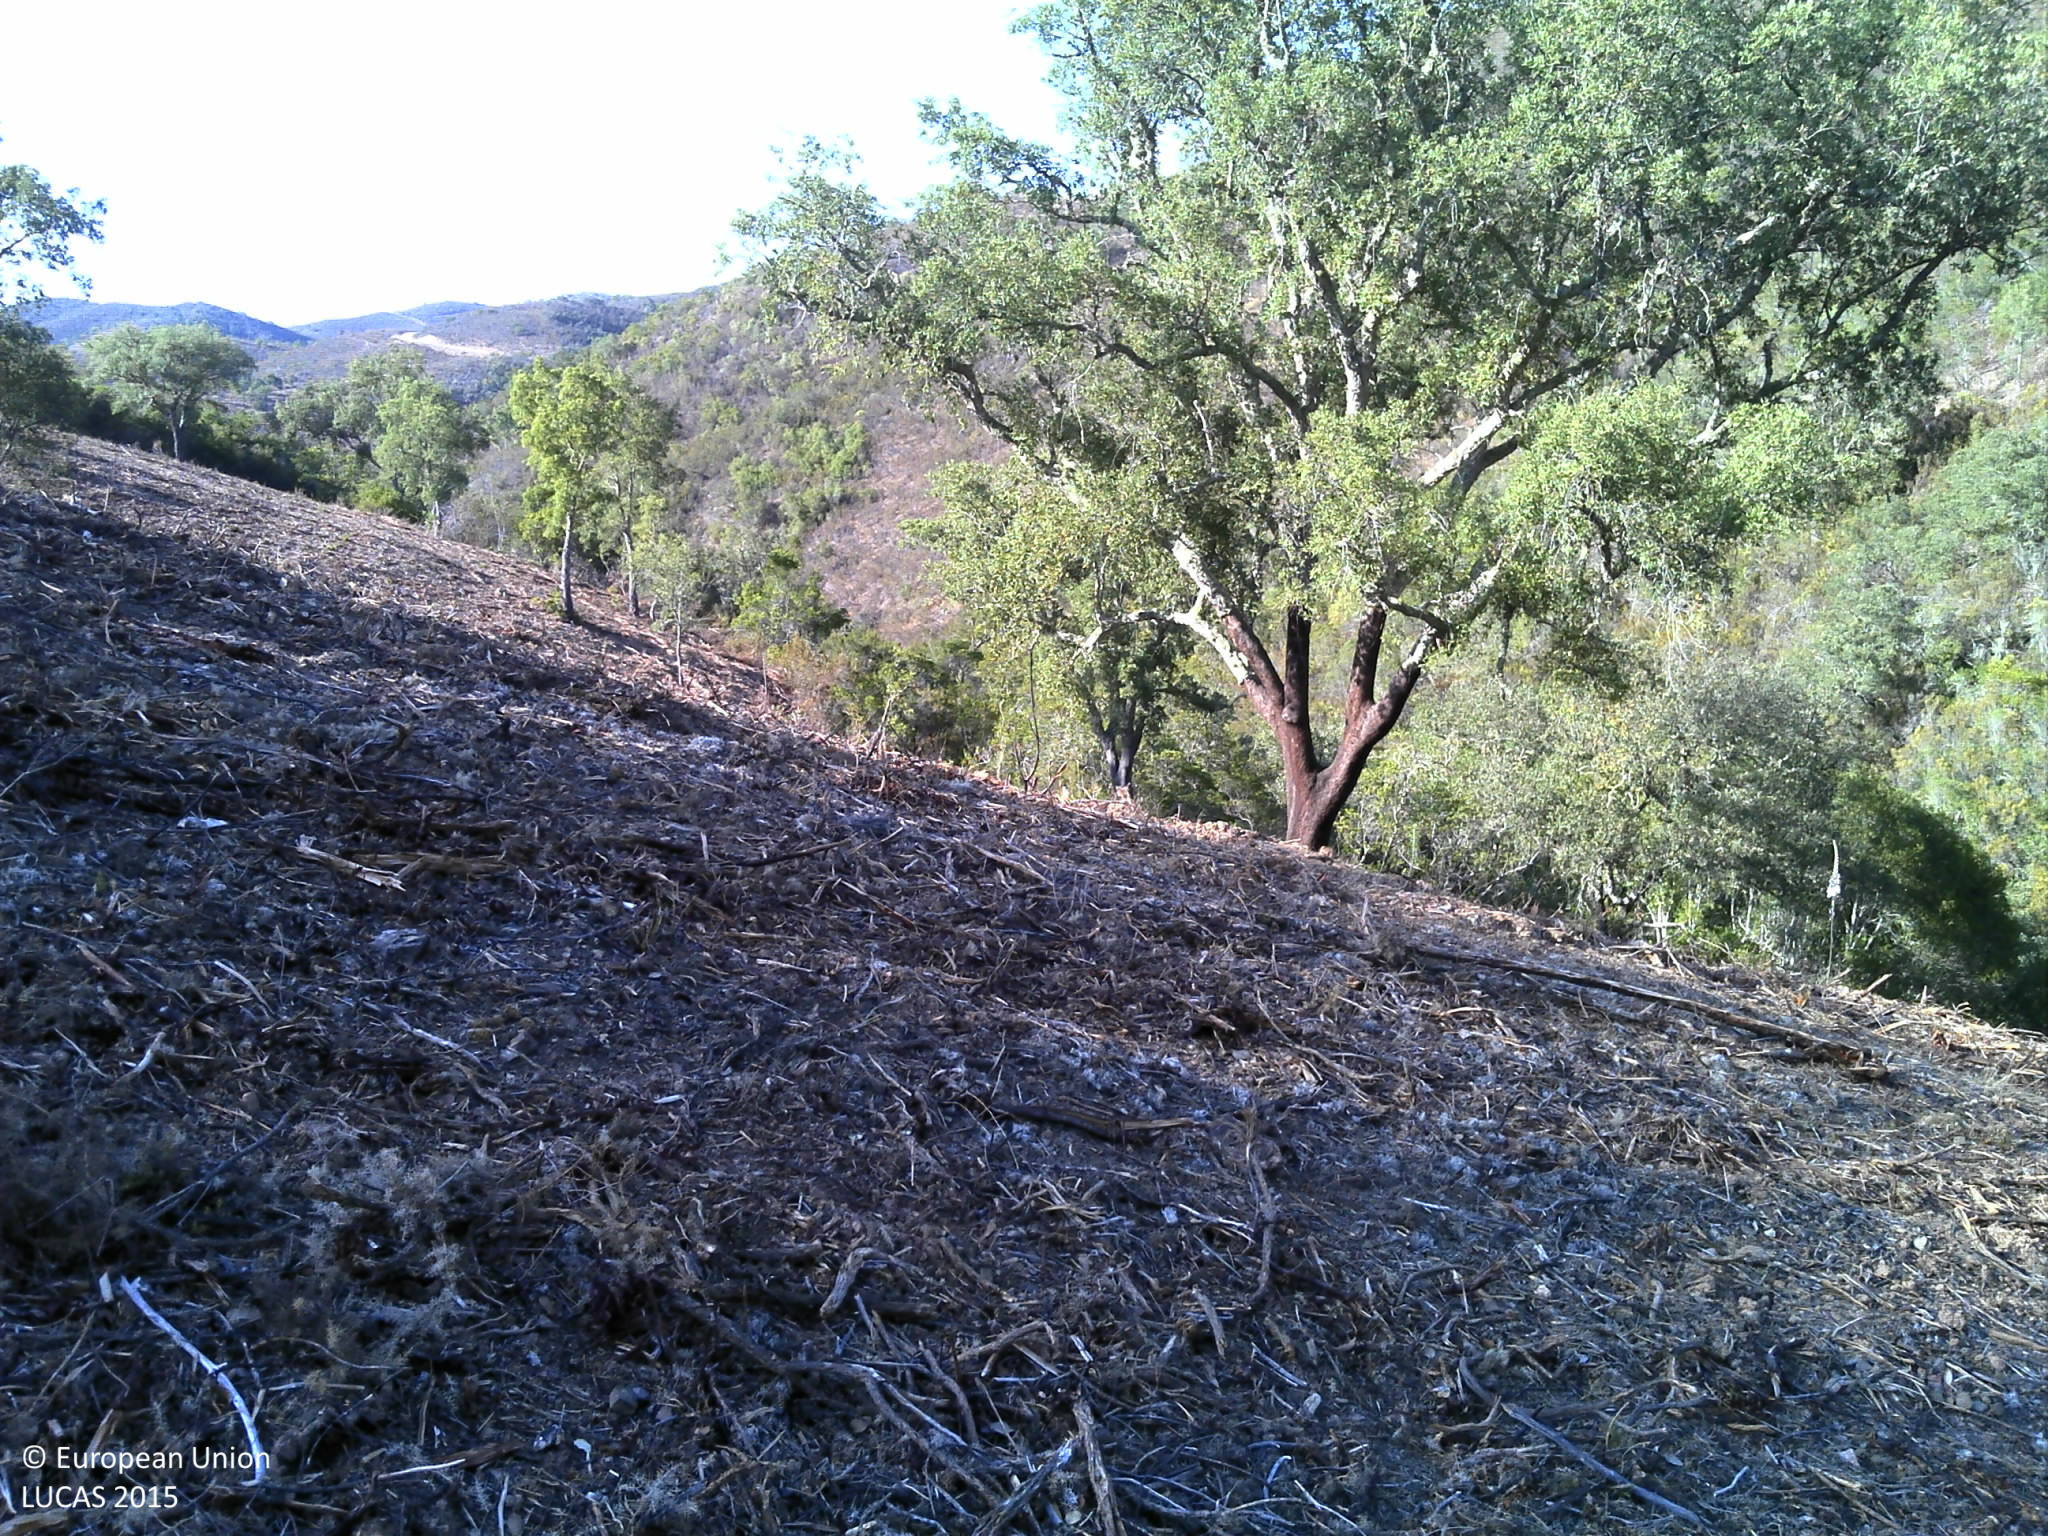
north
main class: Woodland
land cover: Broadleaved woodland
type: broadleaved evergreen forest
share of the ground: 10 - 25 %
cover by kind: unconsolidated bare surface 80 %, broadleaved forest trees 15 %, shrubs 5 %
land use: Forestry
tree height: > 5 m
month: September
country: PT
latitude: 37.4149
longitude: -8.2261
